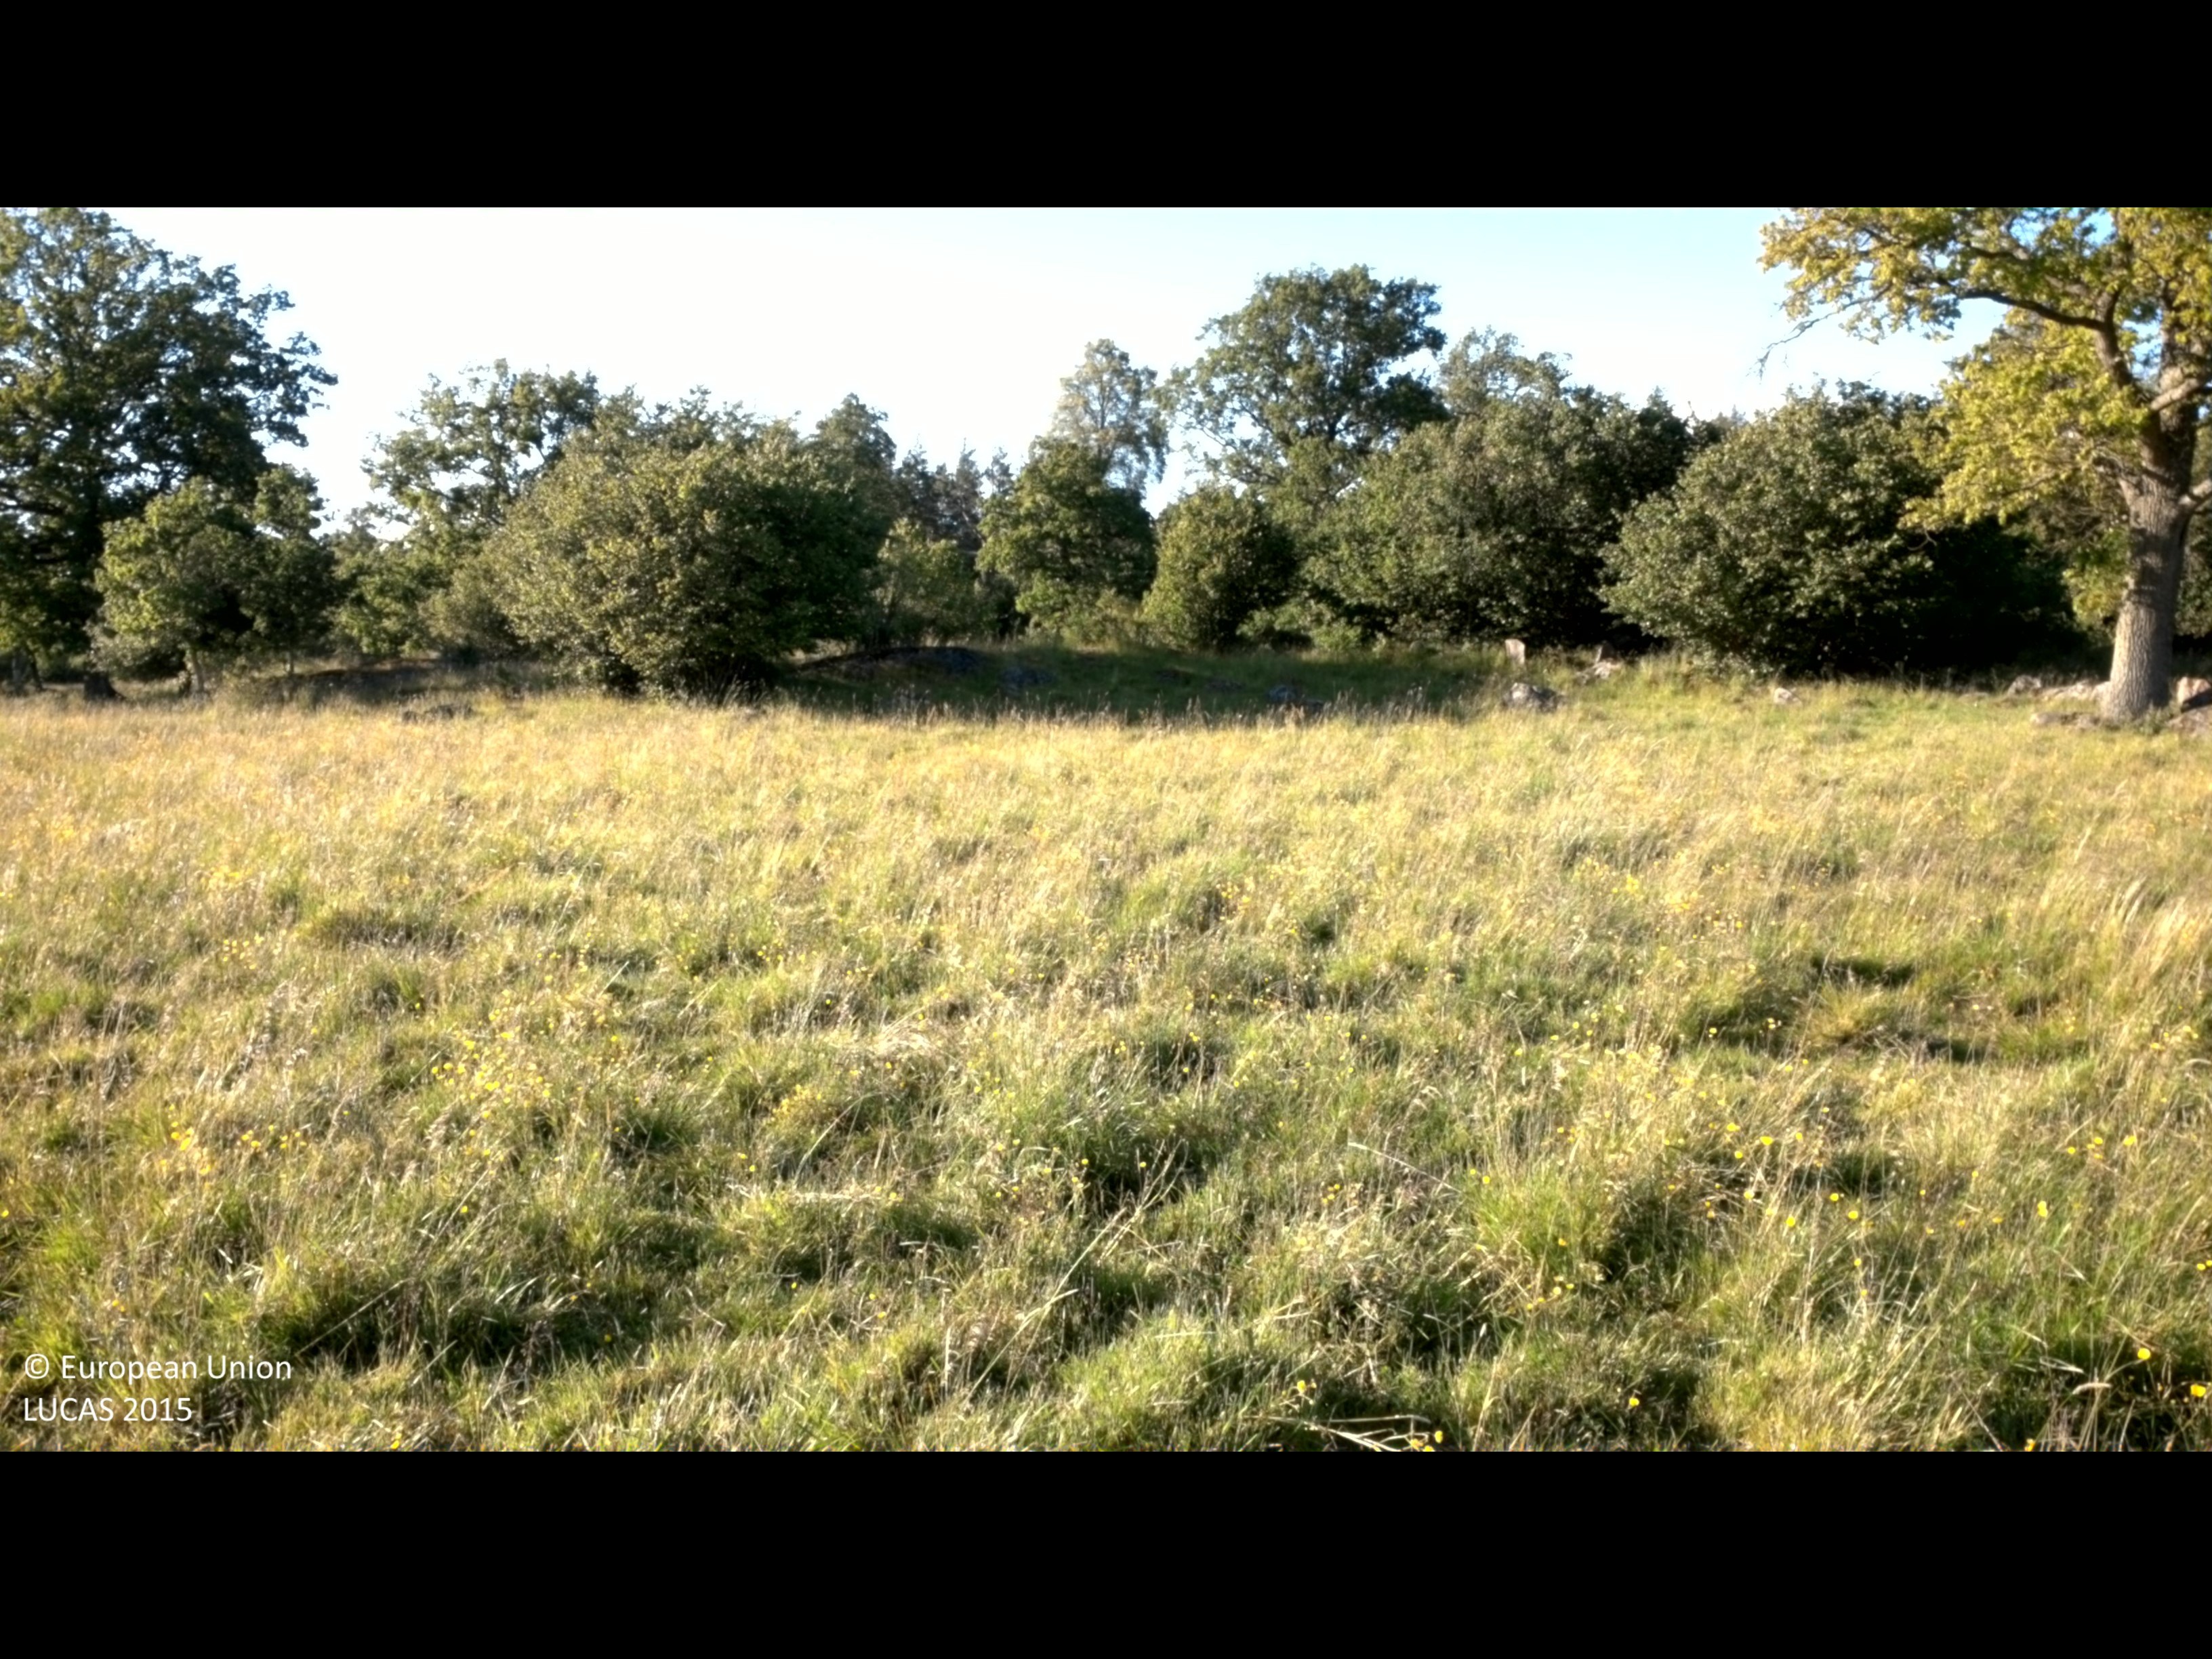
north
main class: Grassland
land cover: Grassland with sparse tree/shrub cover
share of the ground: > 75 %
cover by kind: herbaceous plants 95 %, broadleaved forest trees 5 %
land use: Agriculture (excluding fallow land and kitchen gardens)
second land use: Amenities, museums, leisure
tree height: > 5 m
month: June
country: SE
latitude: 58.3726
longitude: 15.6197
